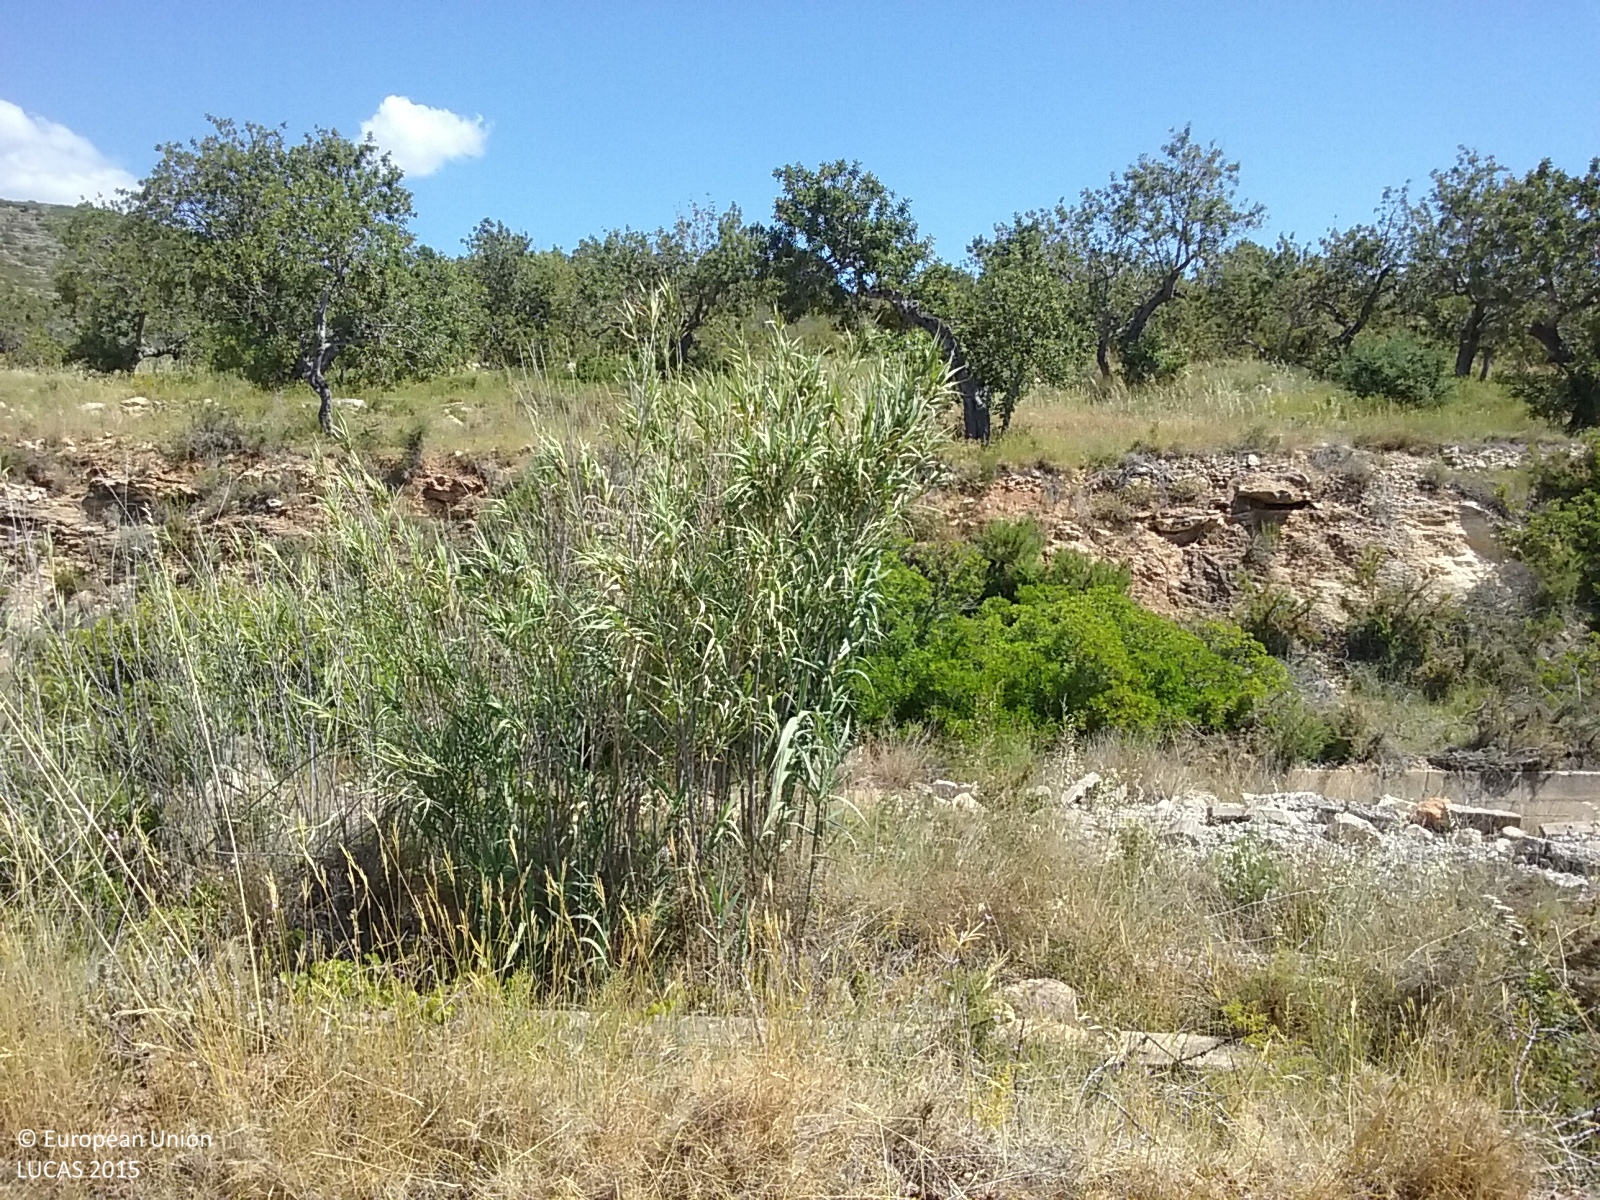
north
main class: Cropland
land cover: Nuts trees
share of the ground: < 10 %
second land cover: Other bare soil
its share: > 75 %
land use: Agriculture (excluding fallow land and kitchen gardens)
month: May
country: ES
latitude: 40.2721
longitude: 0.2484
